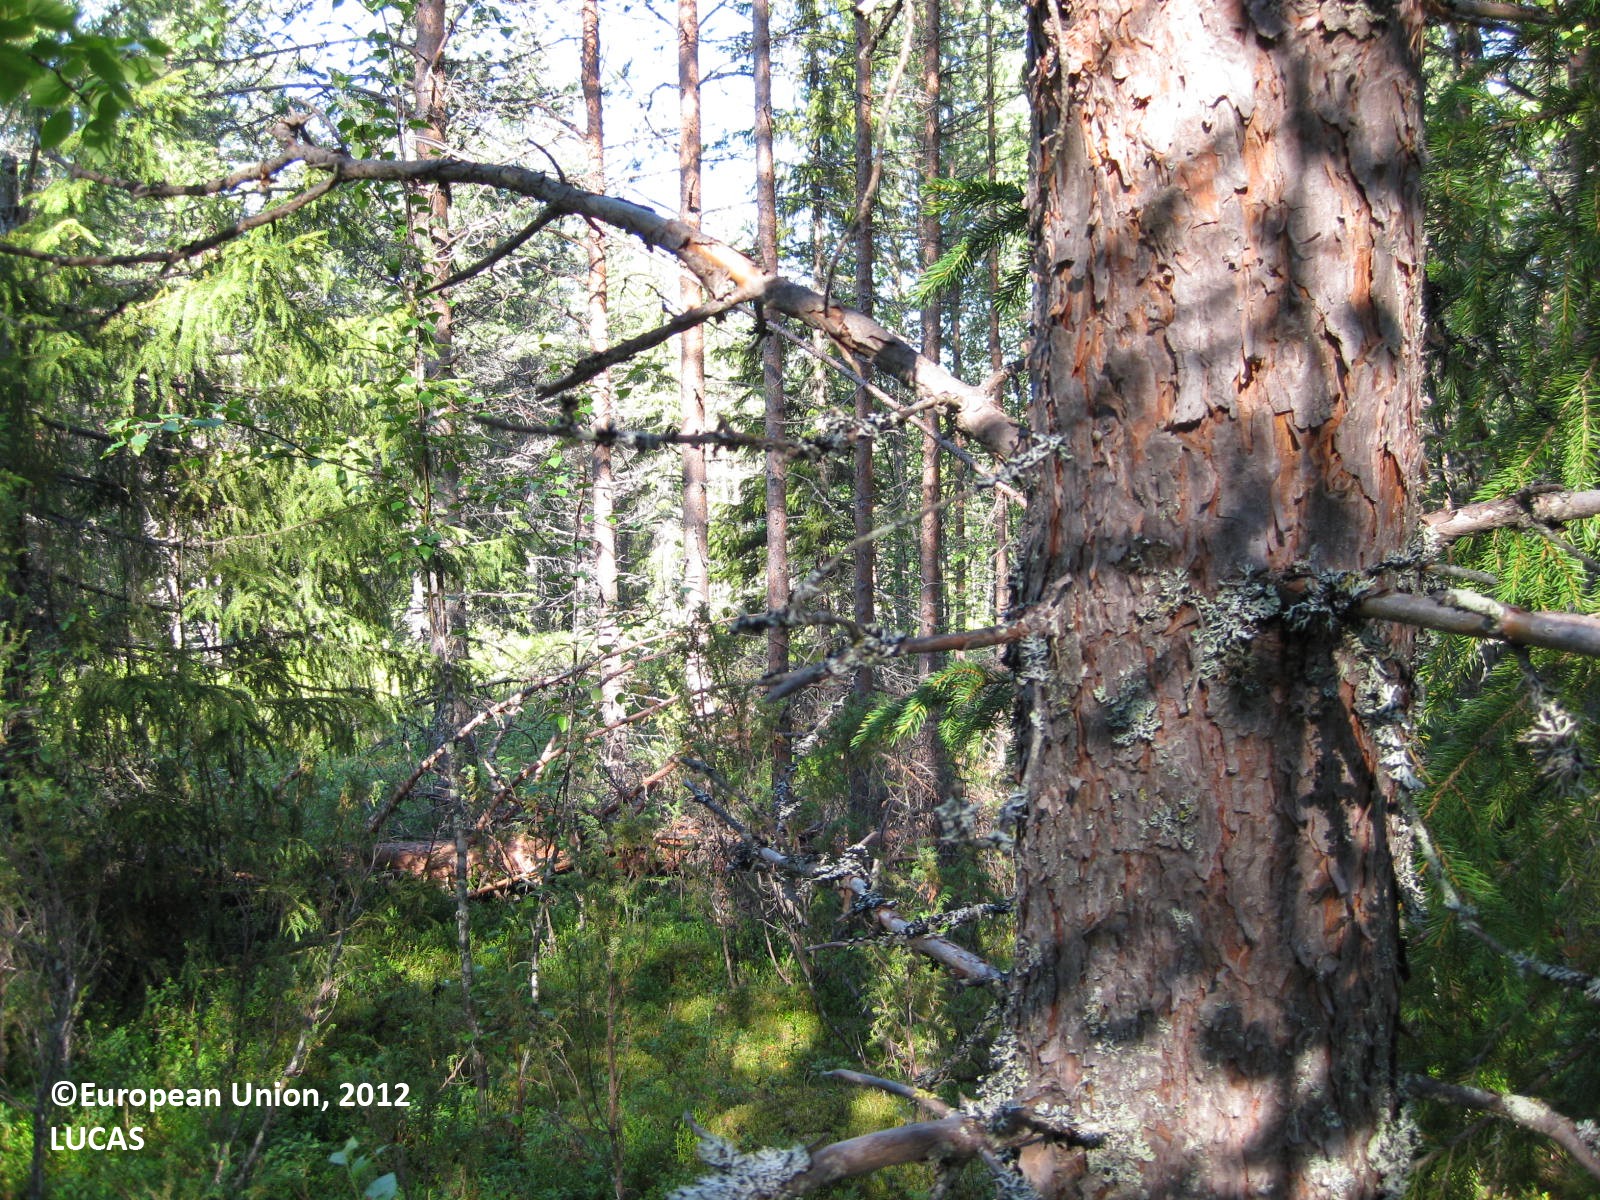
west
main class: Woodland
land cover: Pine dominated mixed woodland
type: boreal forest
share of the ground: > 75 %
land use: Forestry
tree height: > 5 m
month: July
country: FI
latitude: 65.6310
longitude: 28.3336
